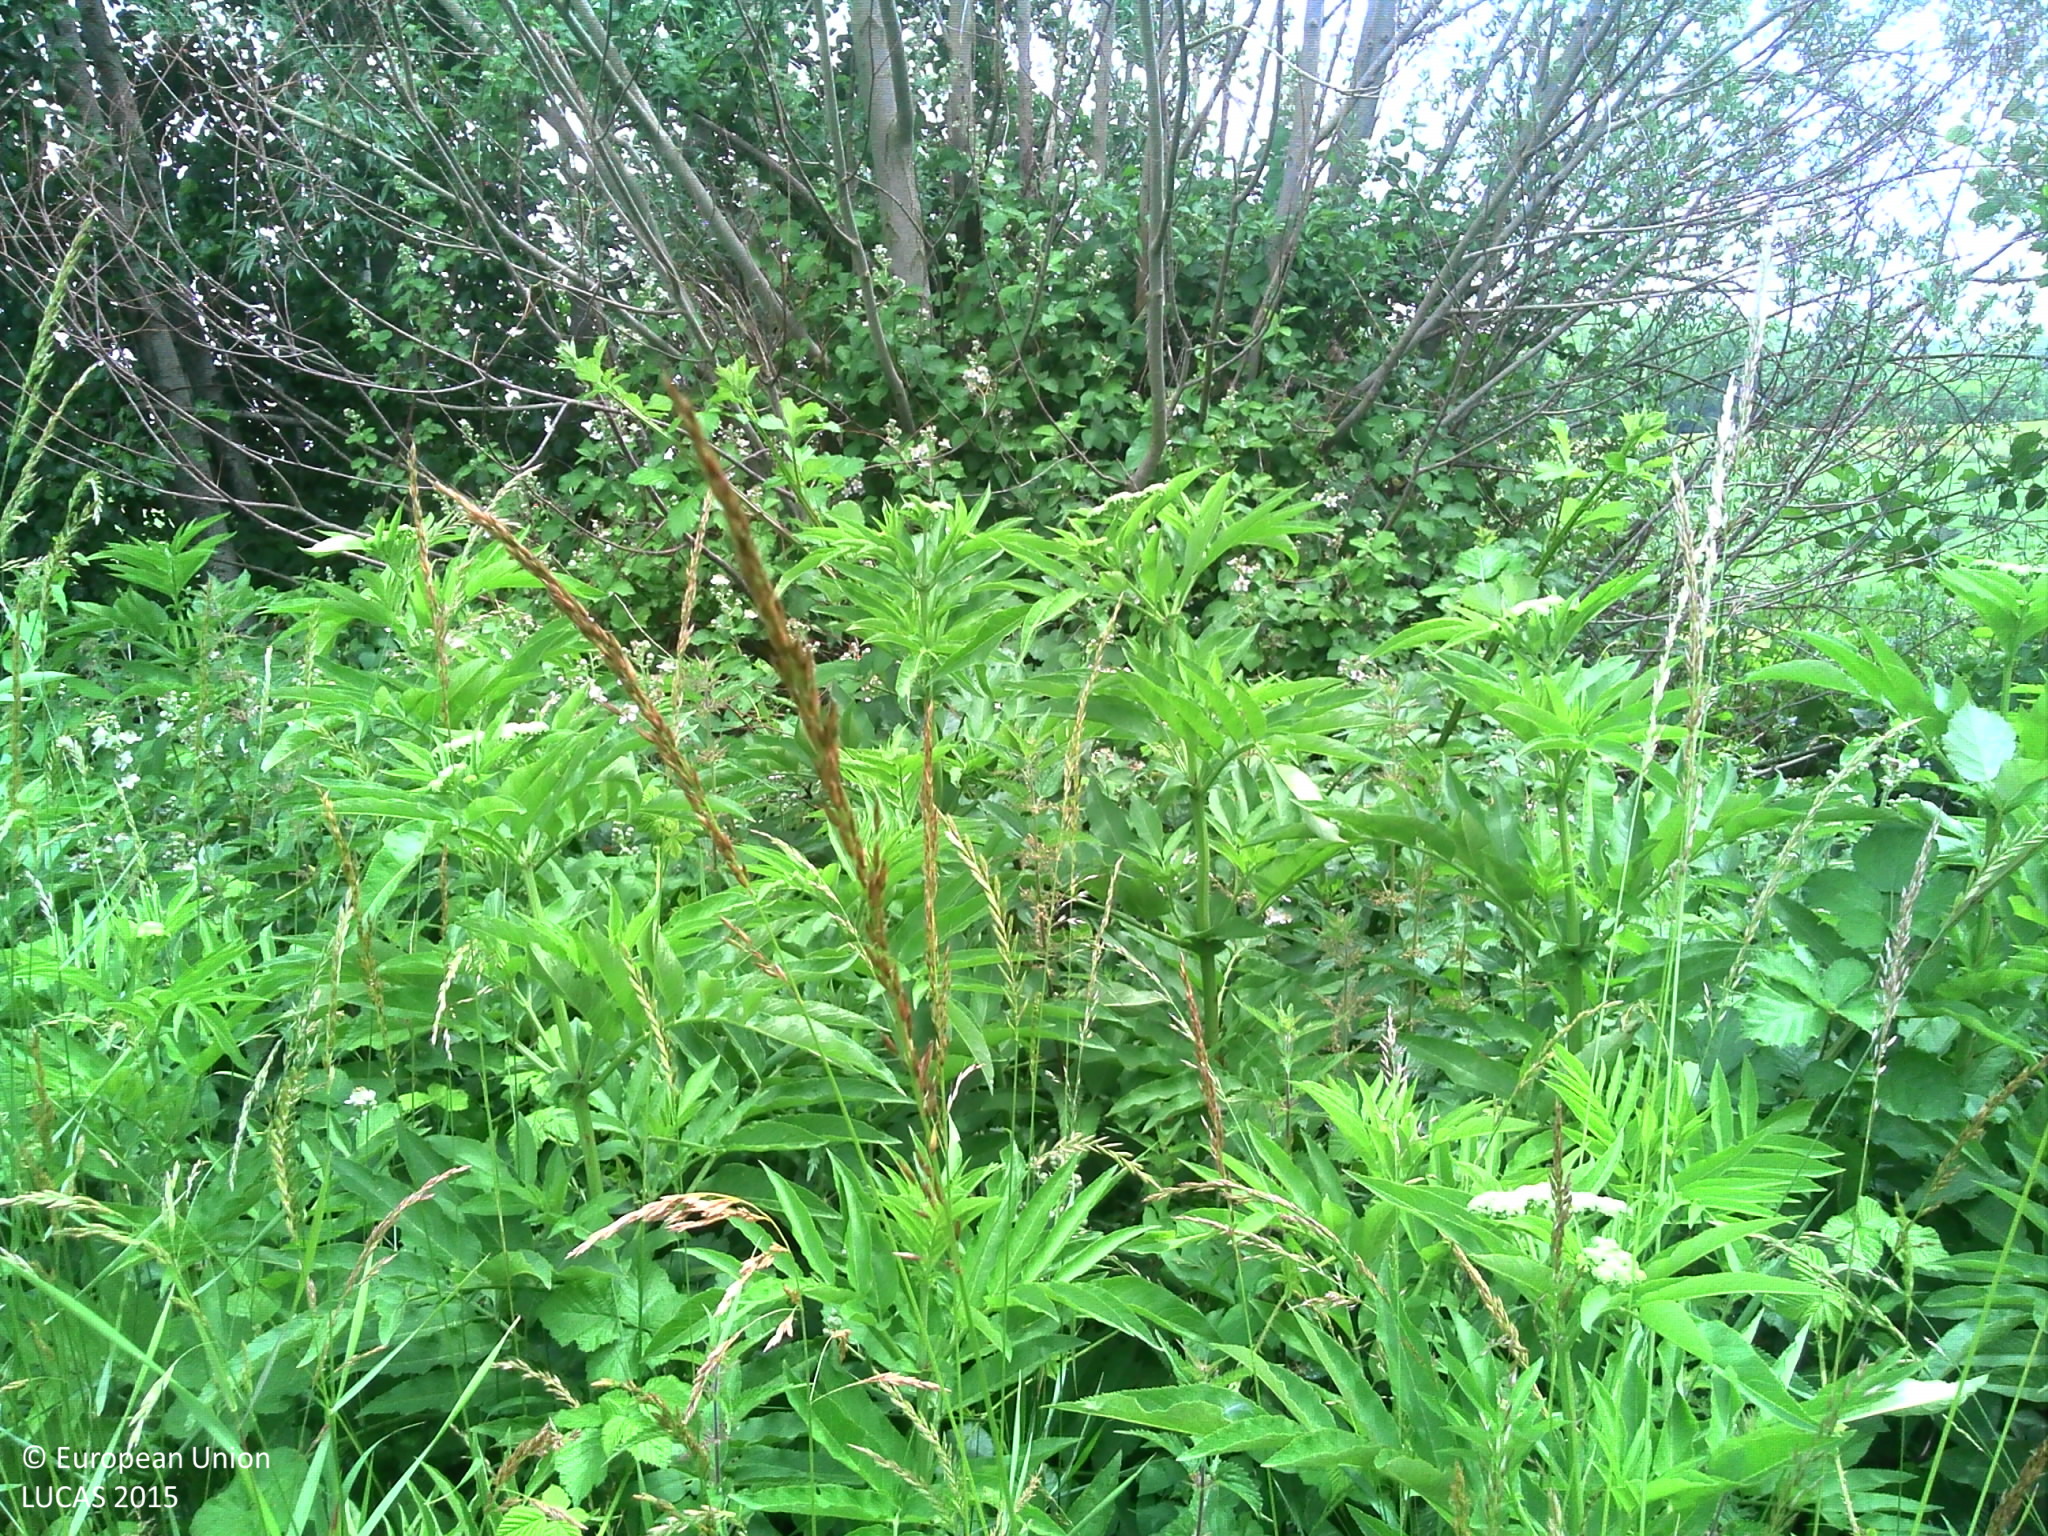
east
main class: Grassland
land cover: Grassland without tree/shrub cover
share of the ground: > 75 %
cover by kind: herbaceous plants 100 %
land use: Agriculture (excluding fallow land and kitchen gardens)
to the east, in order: Grassland without tree/shrub cover; Broadleaved woodland; Ditches and canals; Grassland without tree/shrub cover; Common wheat
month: June
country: FR
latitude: 49.3786
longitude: 3.6991
